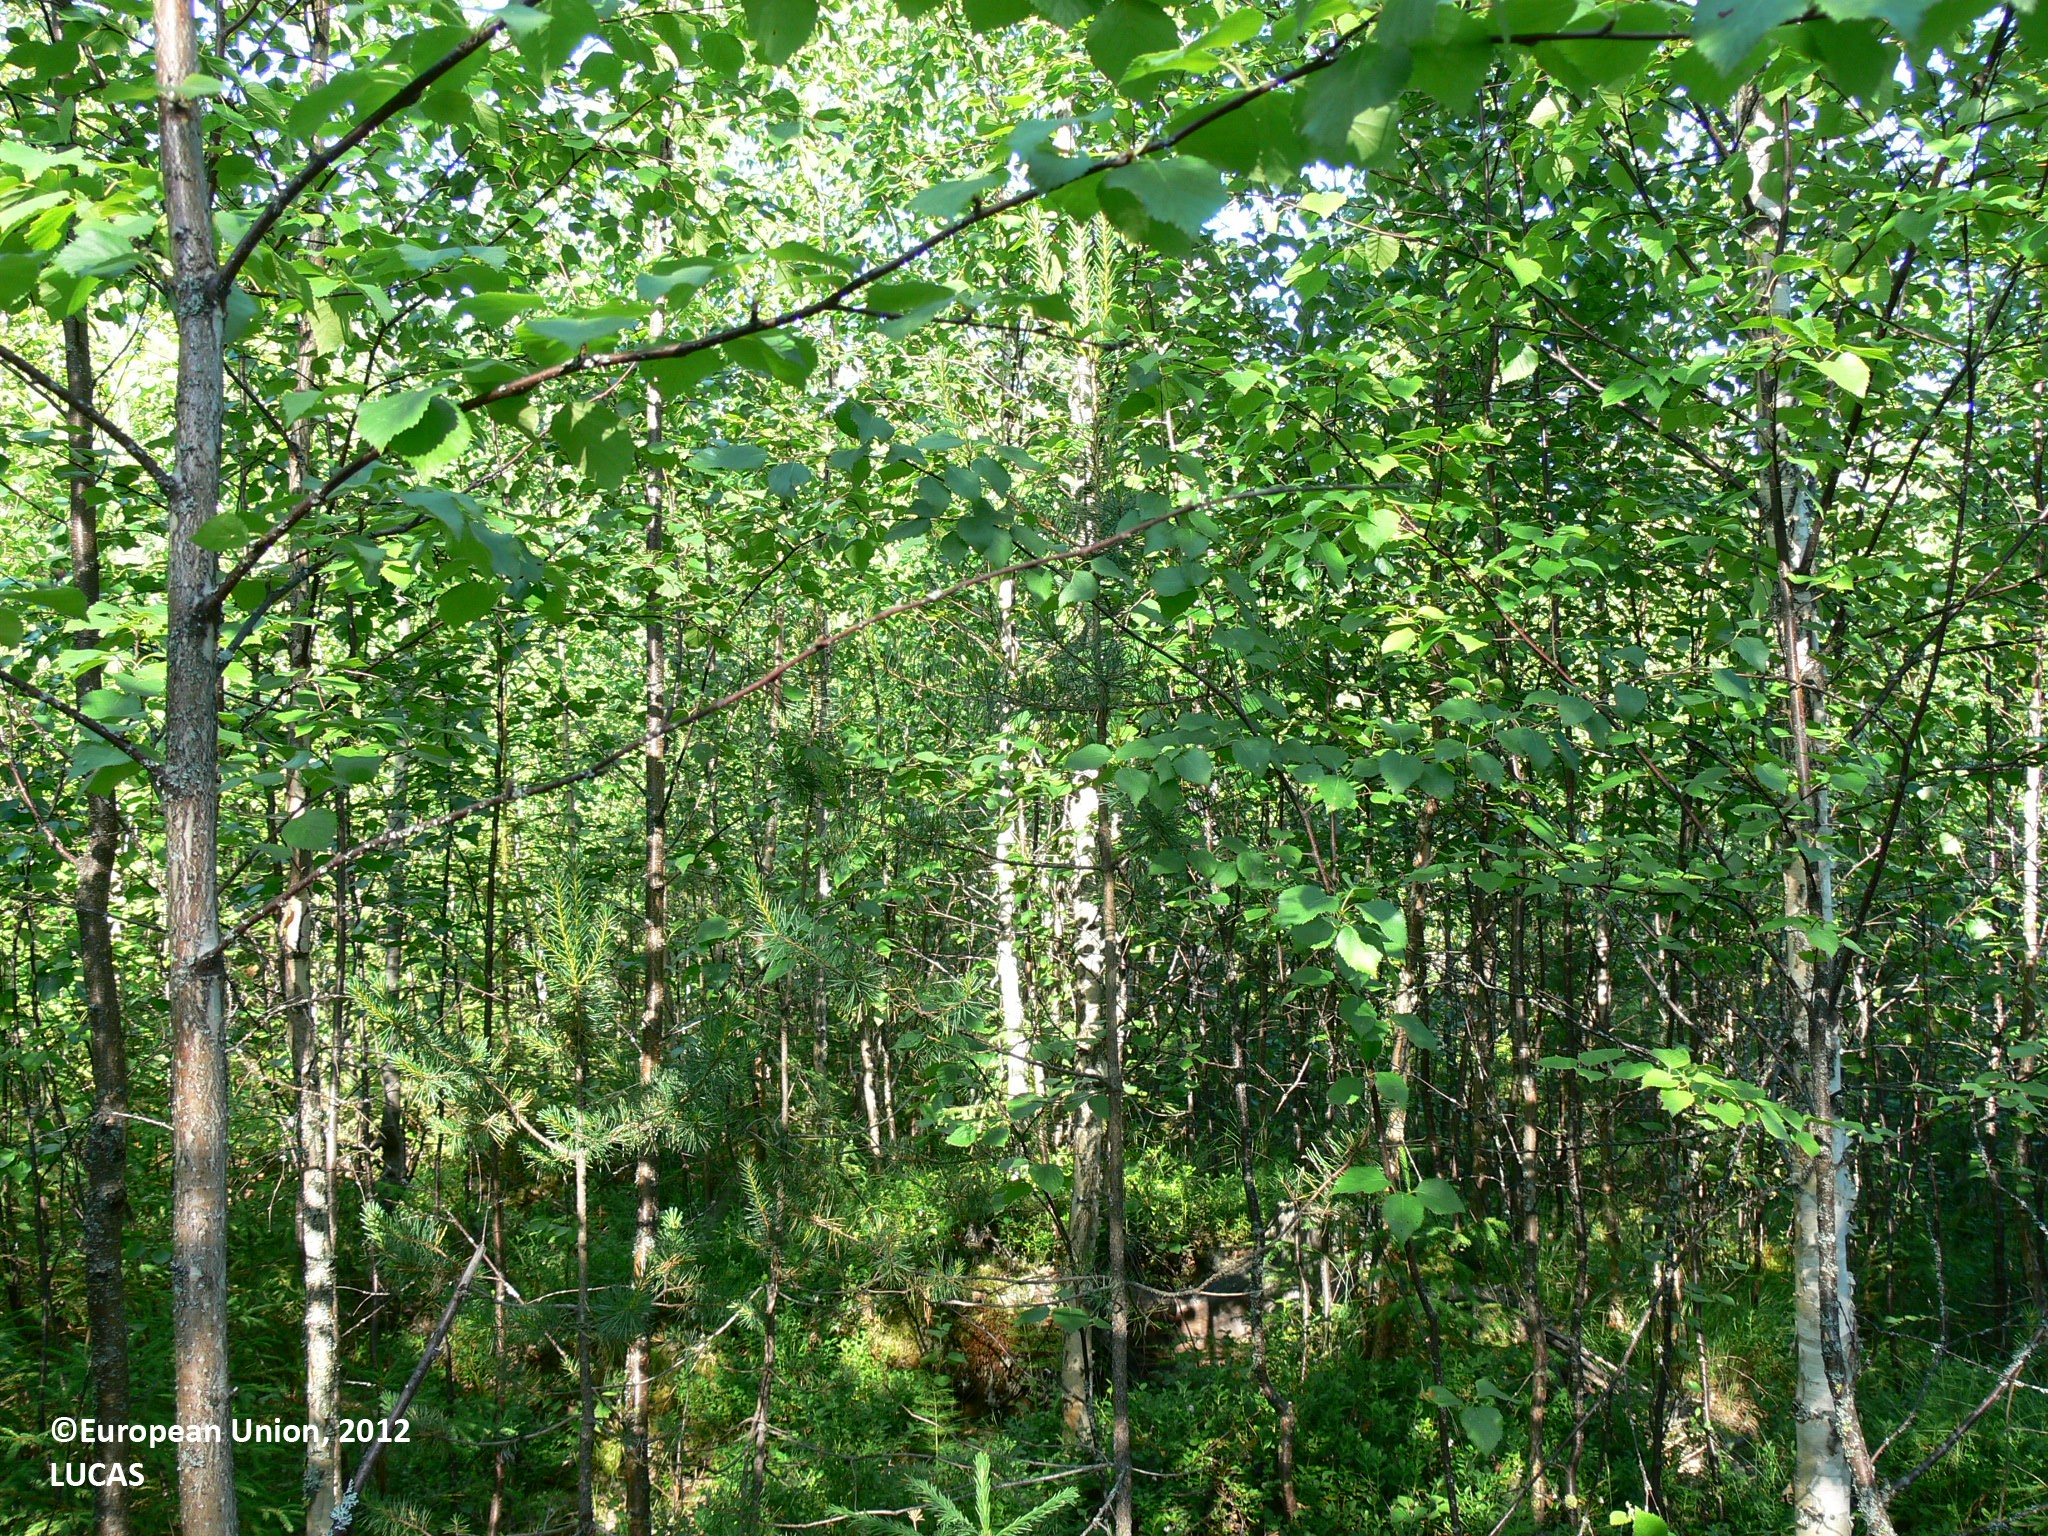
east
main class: Woodland
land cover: Pine dominated mixed woodland
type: boreal forest
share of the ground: > 75 %
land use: Forestry
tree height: > 5 m
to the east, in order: Pine dominated mixed woodland; Grass margins; Electric lines; Grass margins; Paved roads, cycling and walking lanes; Shruby margins; Spruce dominated coniferous woodland; Shruby margins; Paved roads, cycling and walking lanes; Shruby margins; Electric lines; Shruby margins; Spruce dominated coniferous woodland; Spruce dominated mixed woodland; Grass margins; Paved roads, cycling and walking lanes; Grass margins; Other mixed woodland; Broadleaved woodland
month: July
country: FI
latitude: 62.8842
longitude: 30.7619
